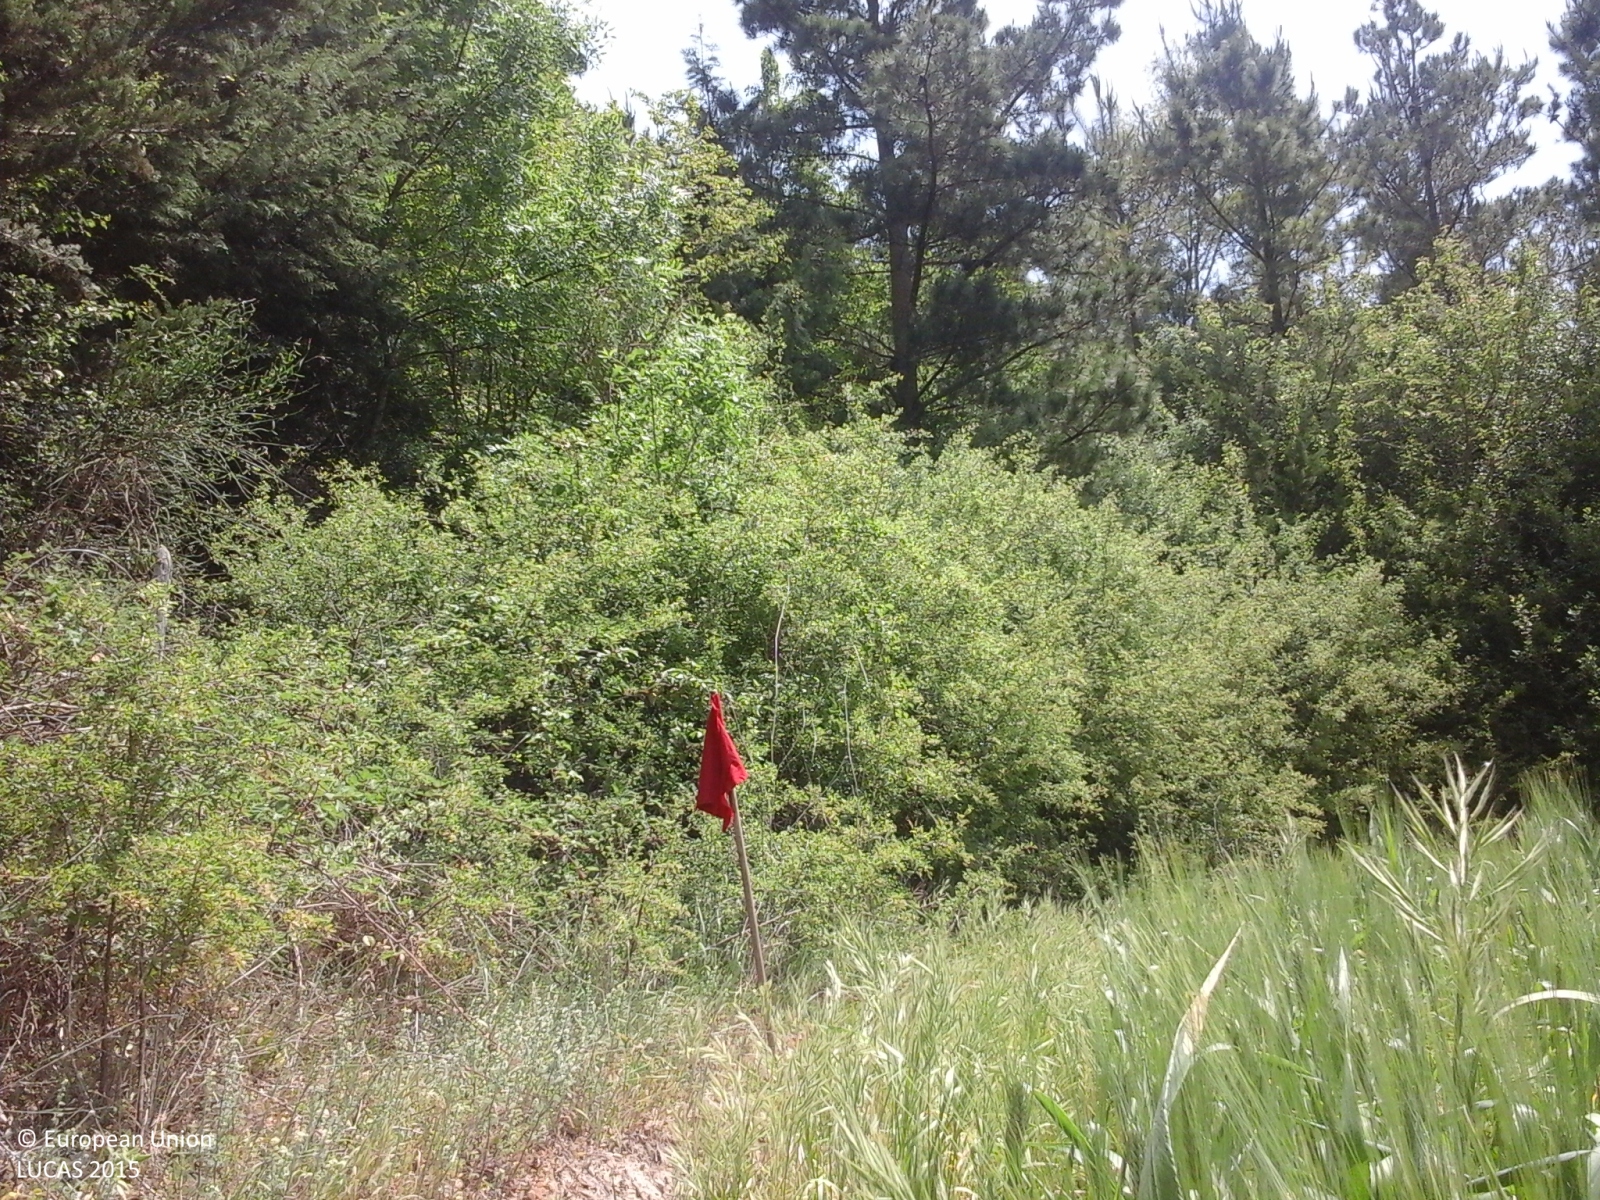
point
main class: Woodland
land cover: Pine dominated mixed woodland
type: coniferous forest of the mediterranean region
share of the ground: > 75 %
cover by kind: coniferous forest trees 60 %, broadleaved forest trees 25 %, shrubs 10 %, herbaceous plants 5 %
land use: Forestry
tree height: > 5 m
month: May
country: IT
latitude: 41.2916
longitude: 14.7948
